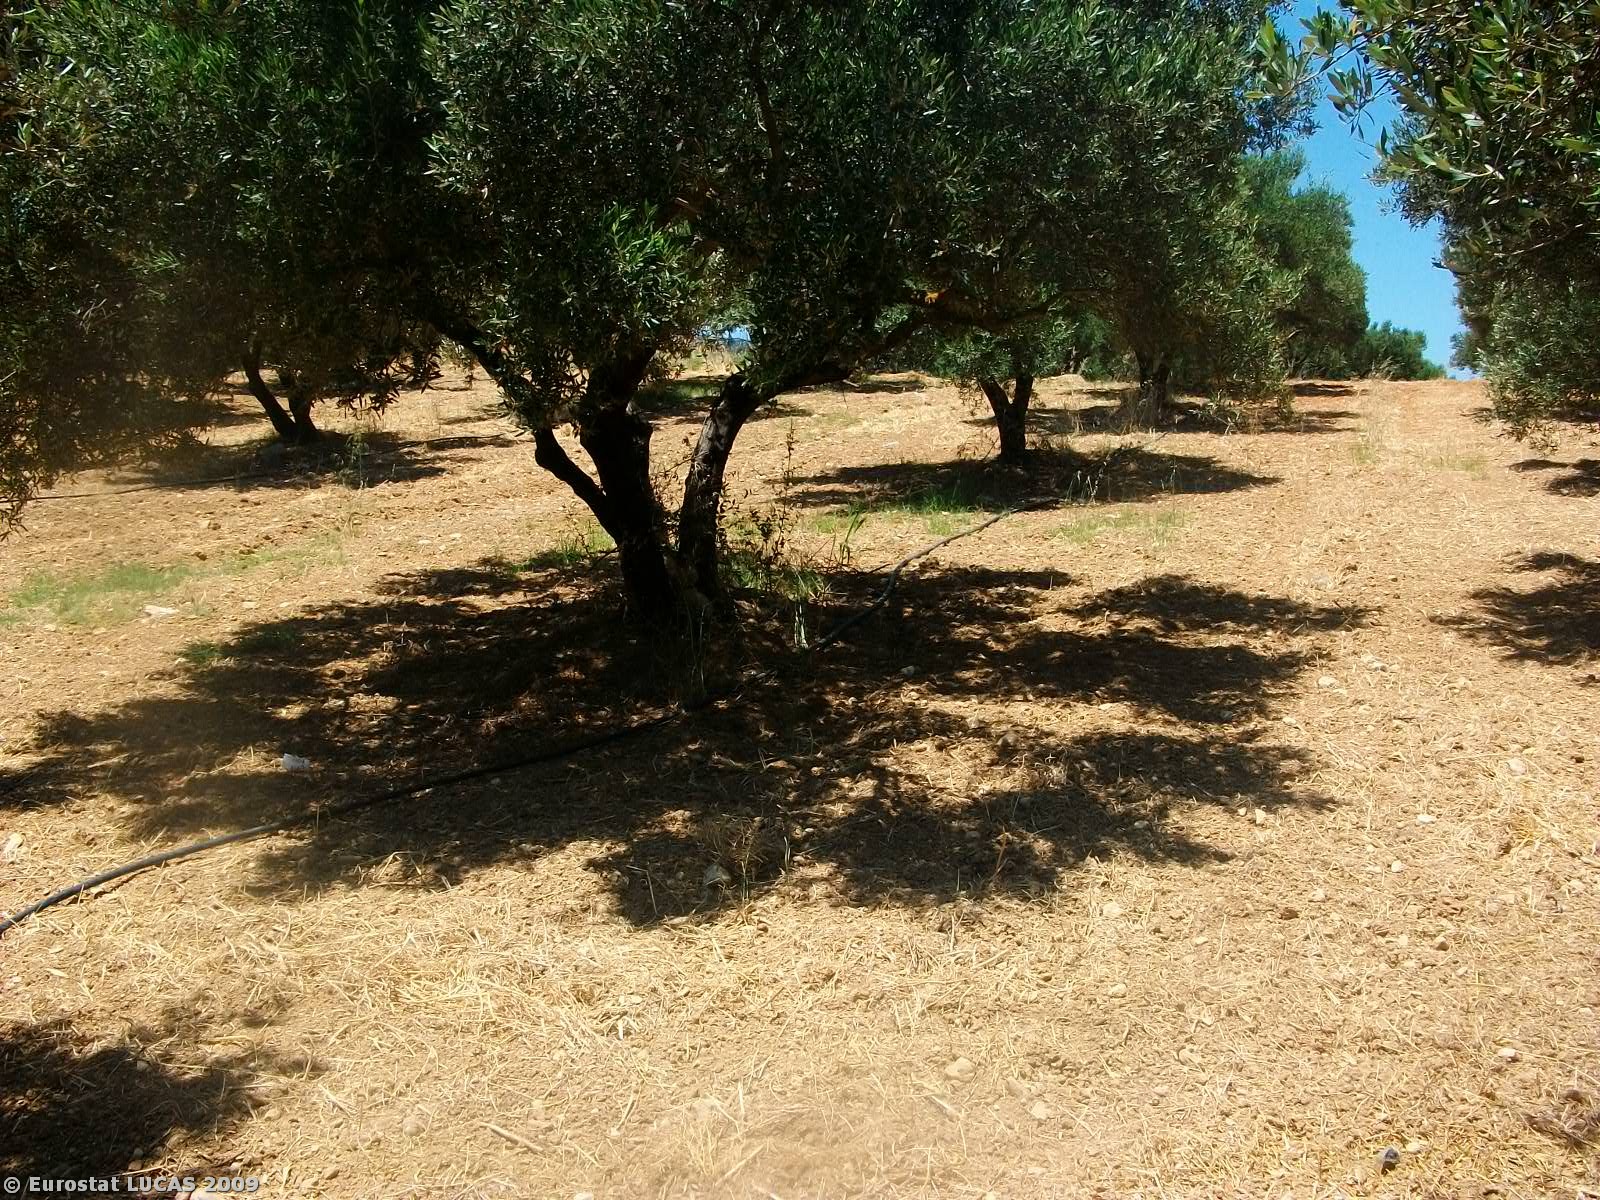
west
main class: Cropland
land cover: Olive groves
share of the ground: > 75 %
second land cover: Bare land
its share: > 75 %
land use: Agriculture (excluding fallow land and kitchen gardens)
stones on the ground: 10 - 25 %
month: June
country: GR
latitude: 35.0549
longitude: 25.0181
